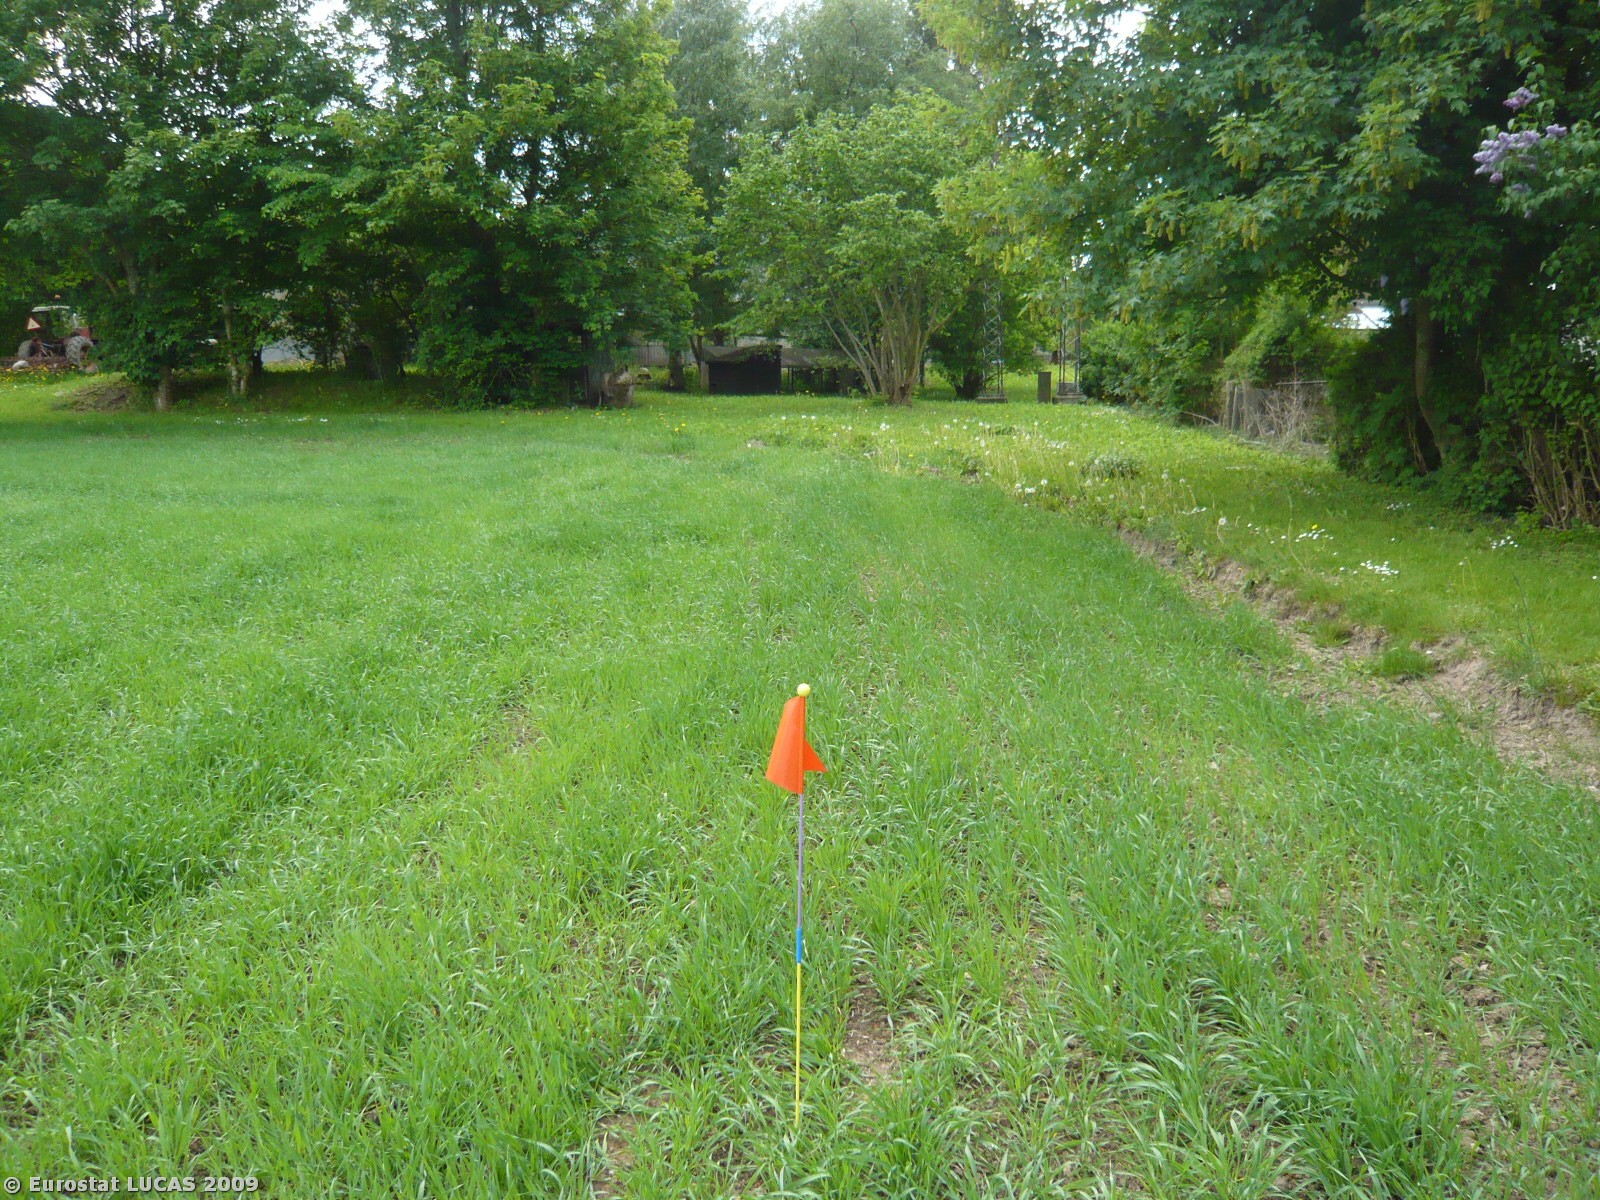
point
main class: Cropland
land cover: Barley
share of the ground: > 75 %
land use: Agriculture (excluding fallow land and kitchen gardens)
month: May
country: DK
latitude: 55.3465
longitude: 11.9066
